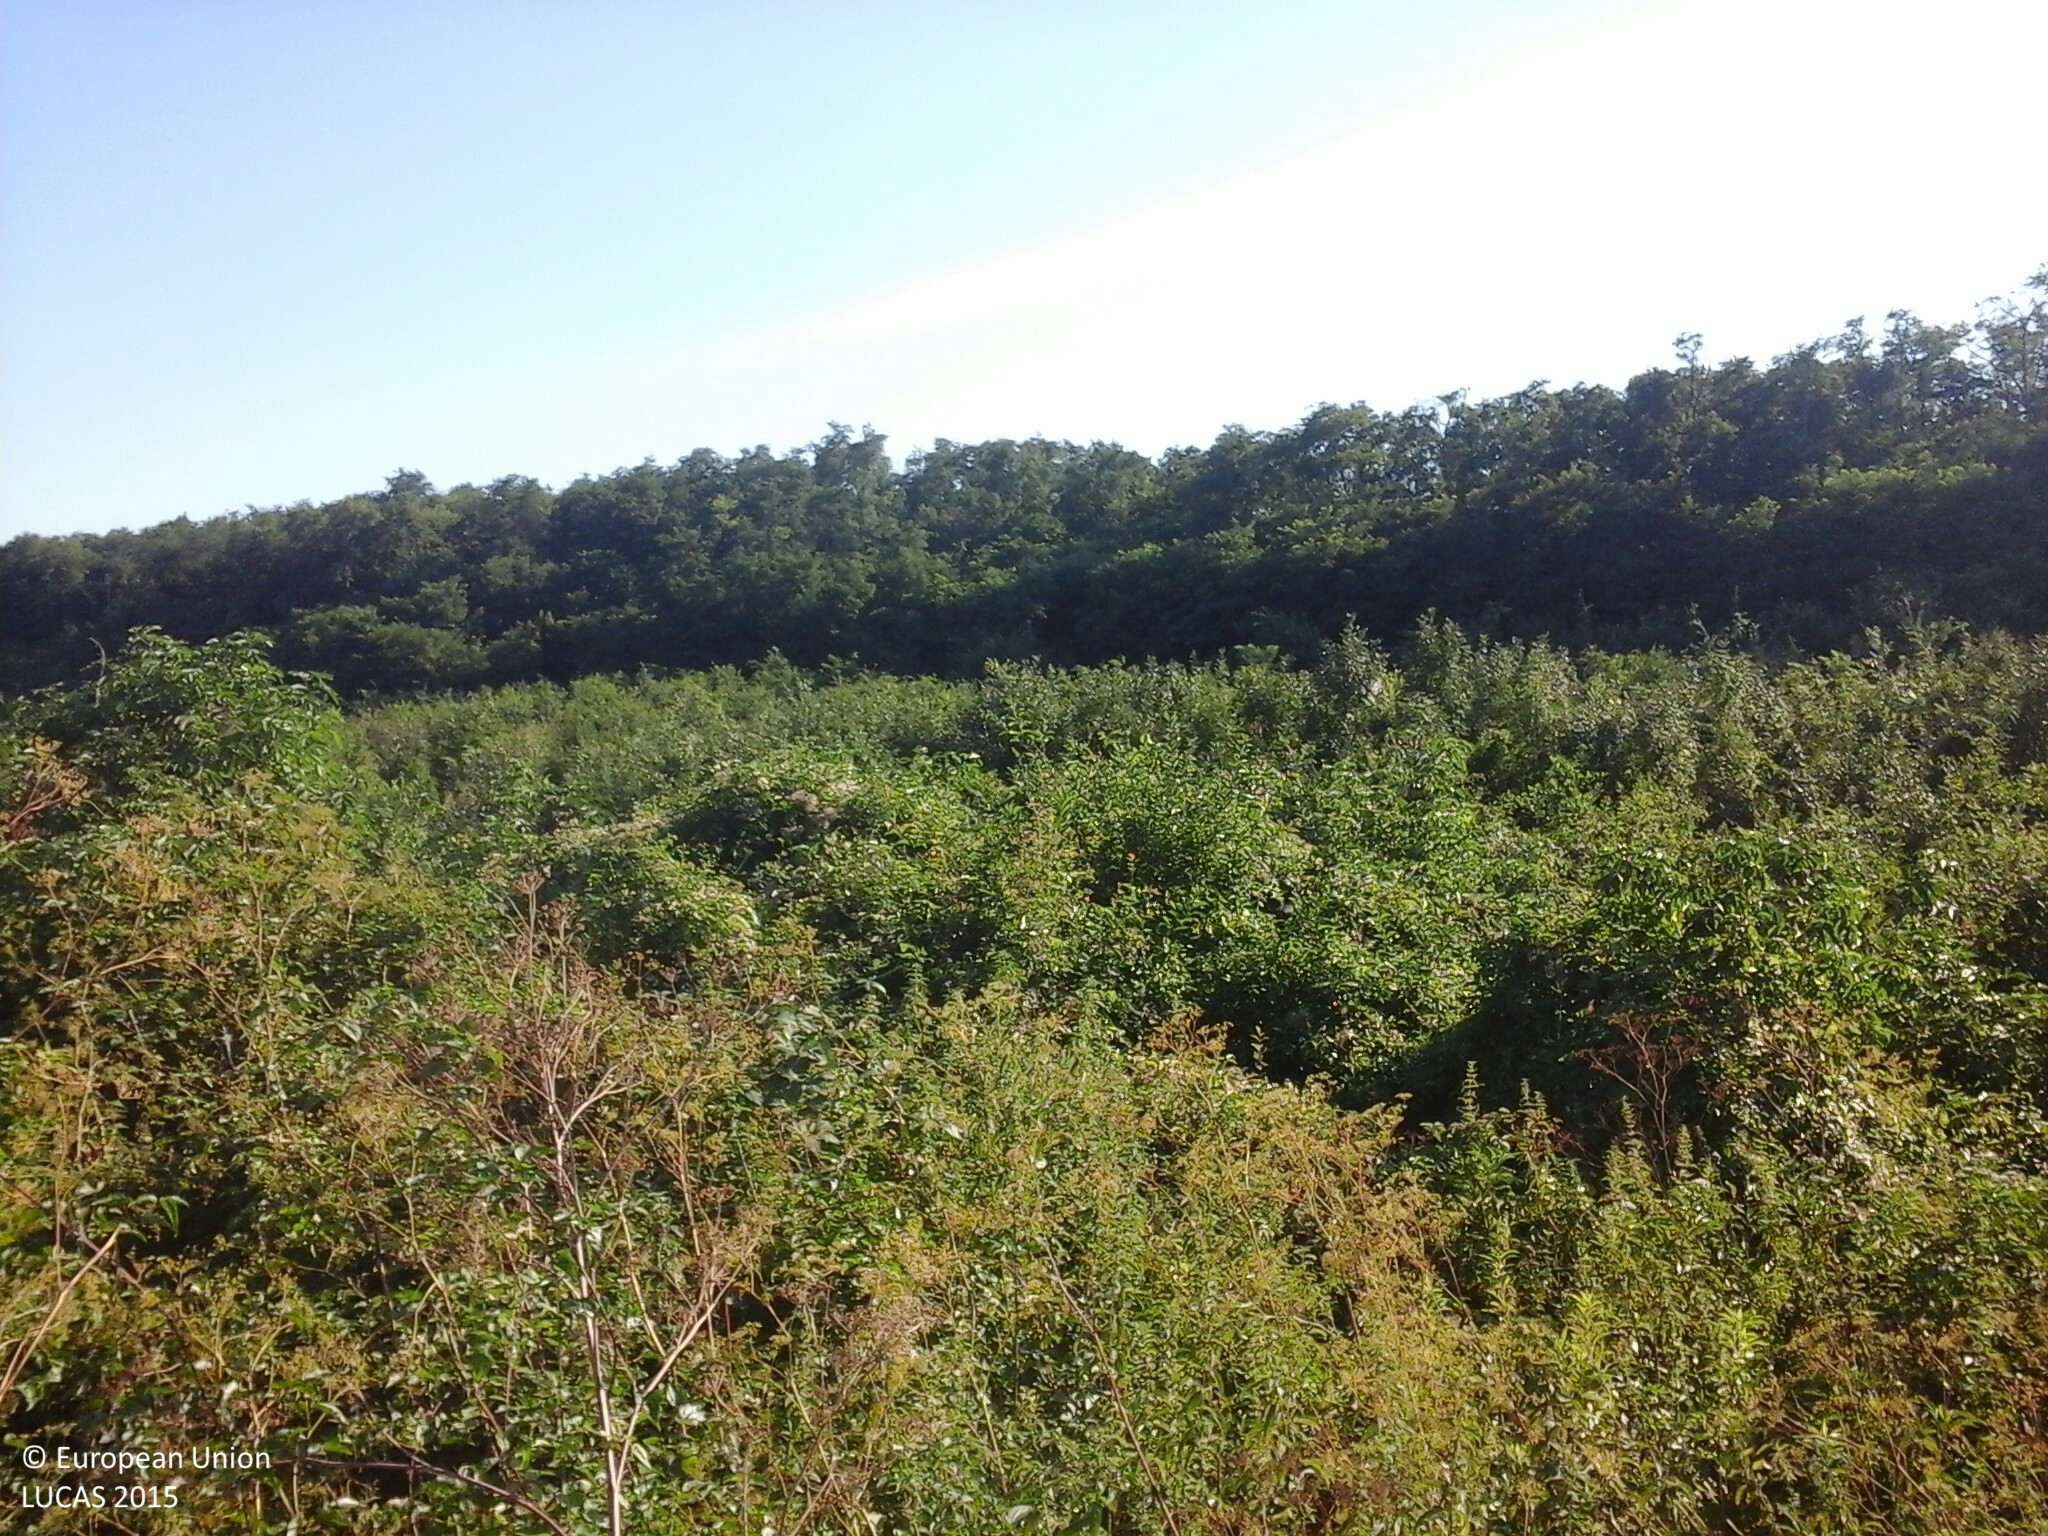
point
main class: Shrubland
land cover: Shrubland with sparse tree cover
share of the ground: > 75 %
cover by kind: shrubs 95 %, broadleaved forest trees 5 %
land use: Semi-natural and natural areas not in use
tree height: < 5 m
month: July
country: HU
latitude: 46.5965
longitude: 17.7208
